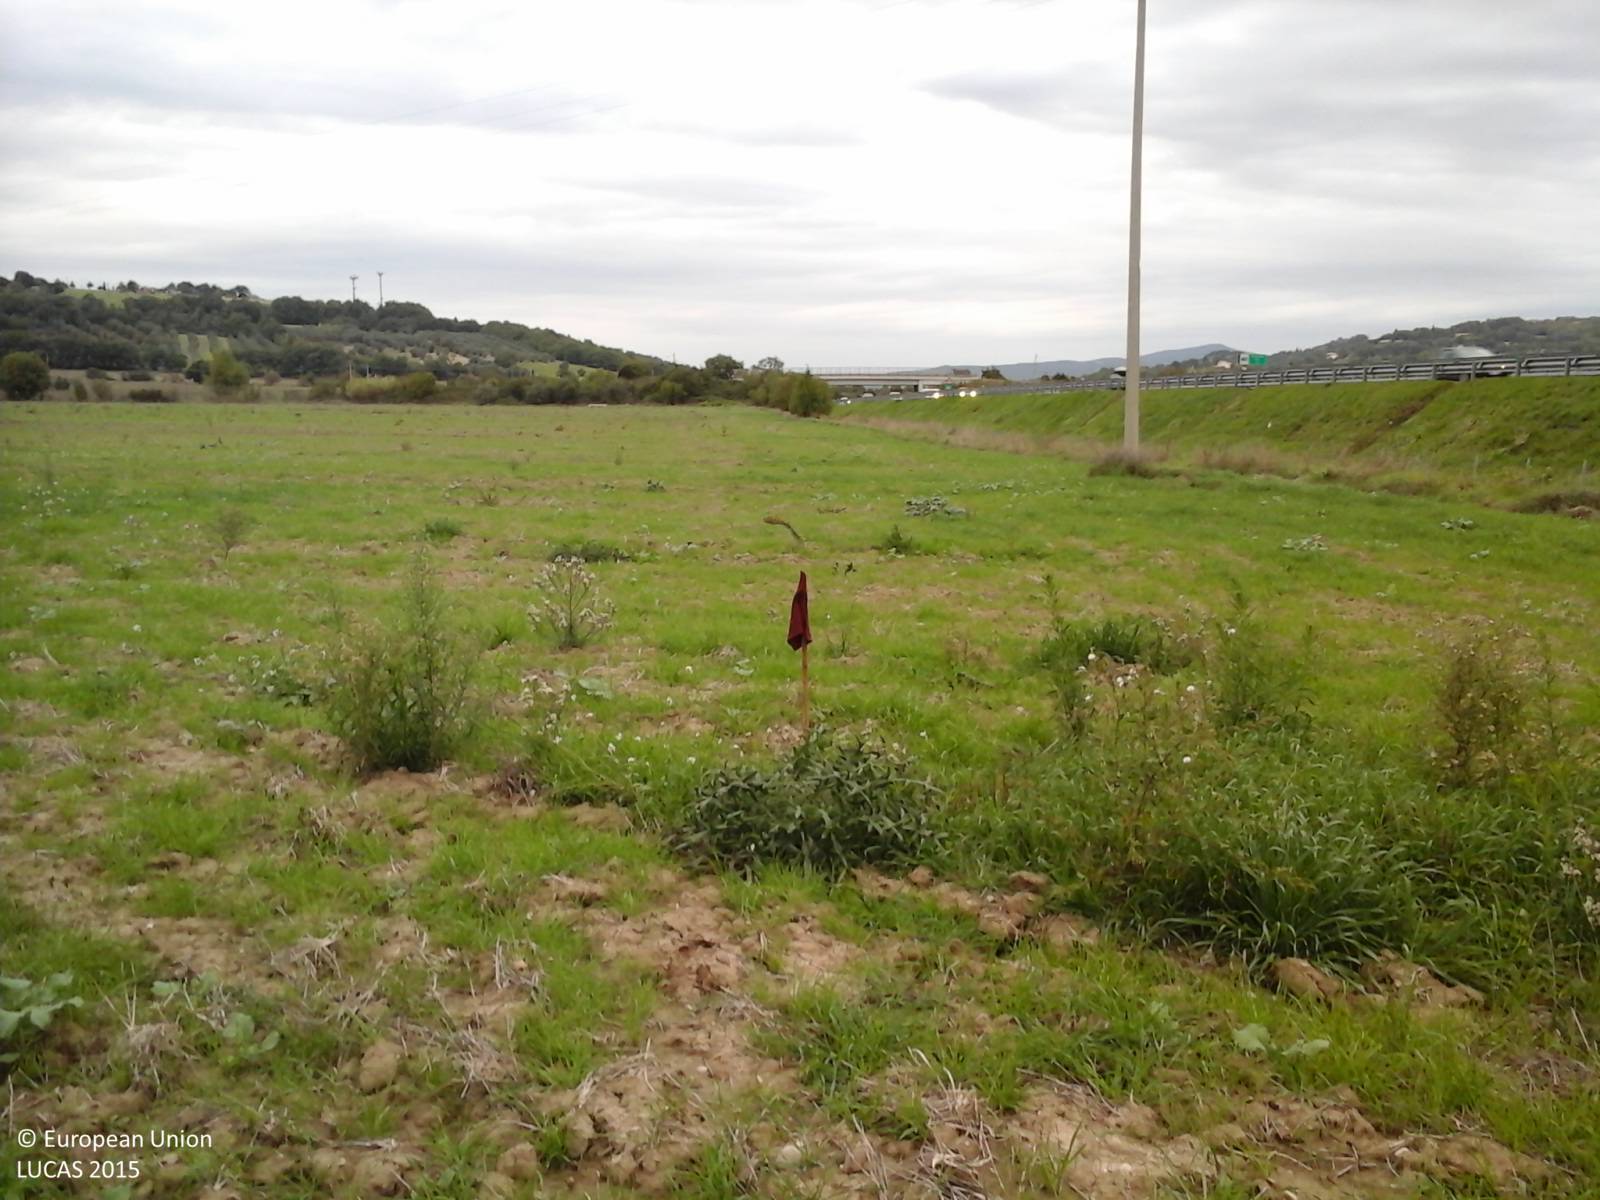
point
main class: Grassland
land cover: Spontaneously vegetated surfaces
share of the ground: > 75 %
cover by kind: herbaceous plants 70 %, unconsolidated bare surface 30 %
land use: Agriculture (excluding fallow land and kitchen gardens)
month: October
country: IT
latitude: 42.6477
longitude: 12.2249
